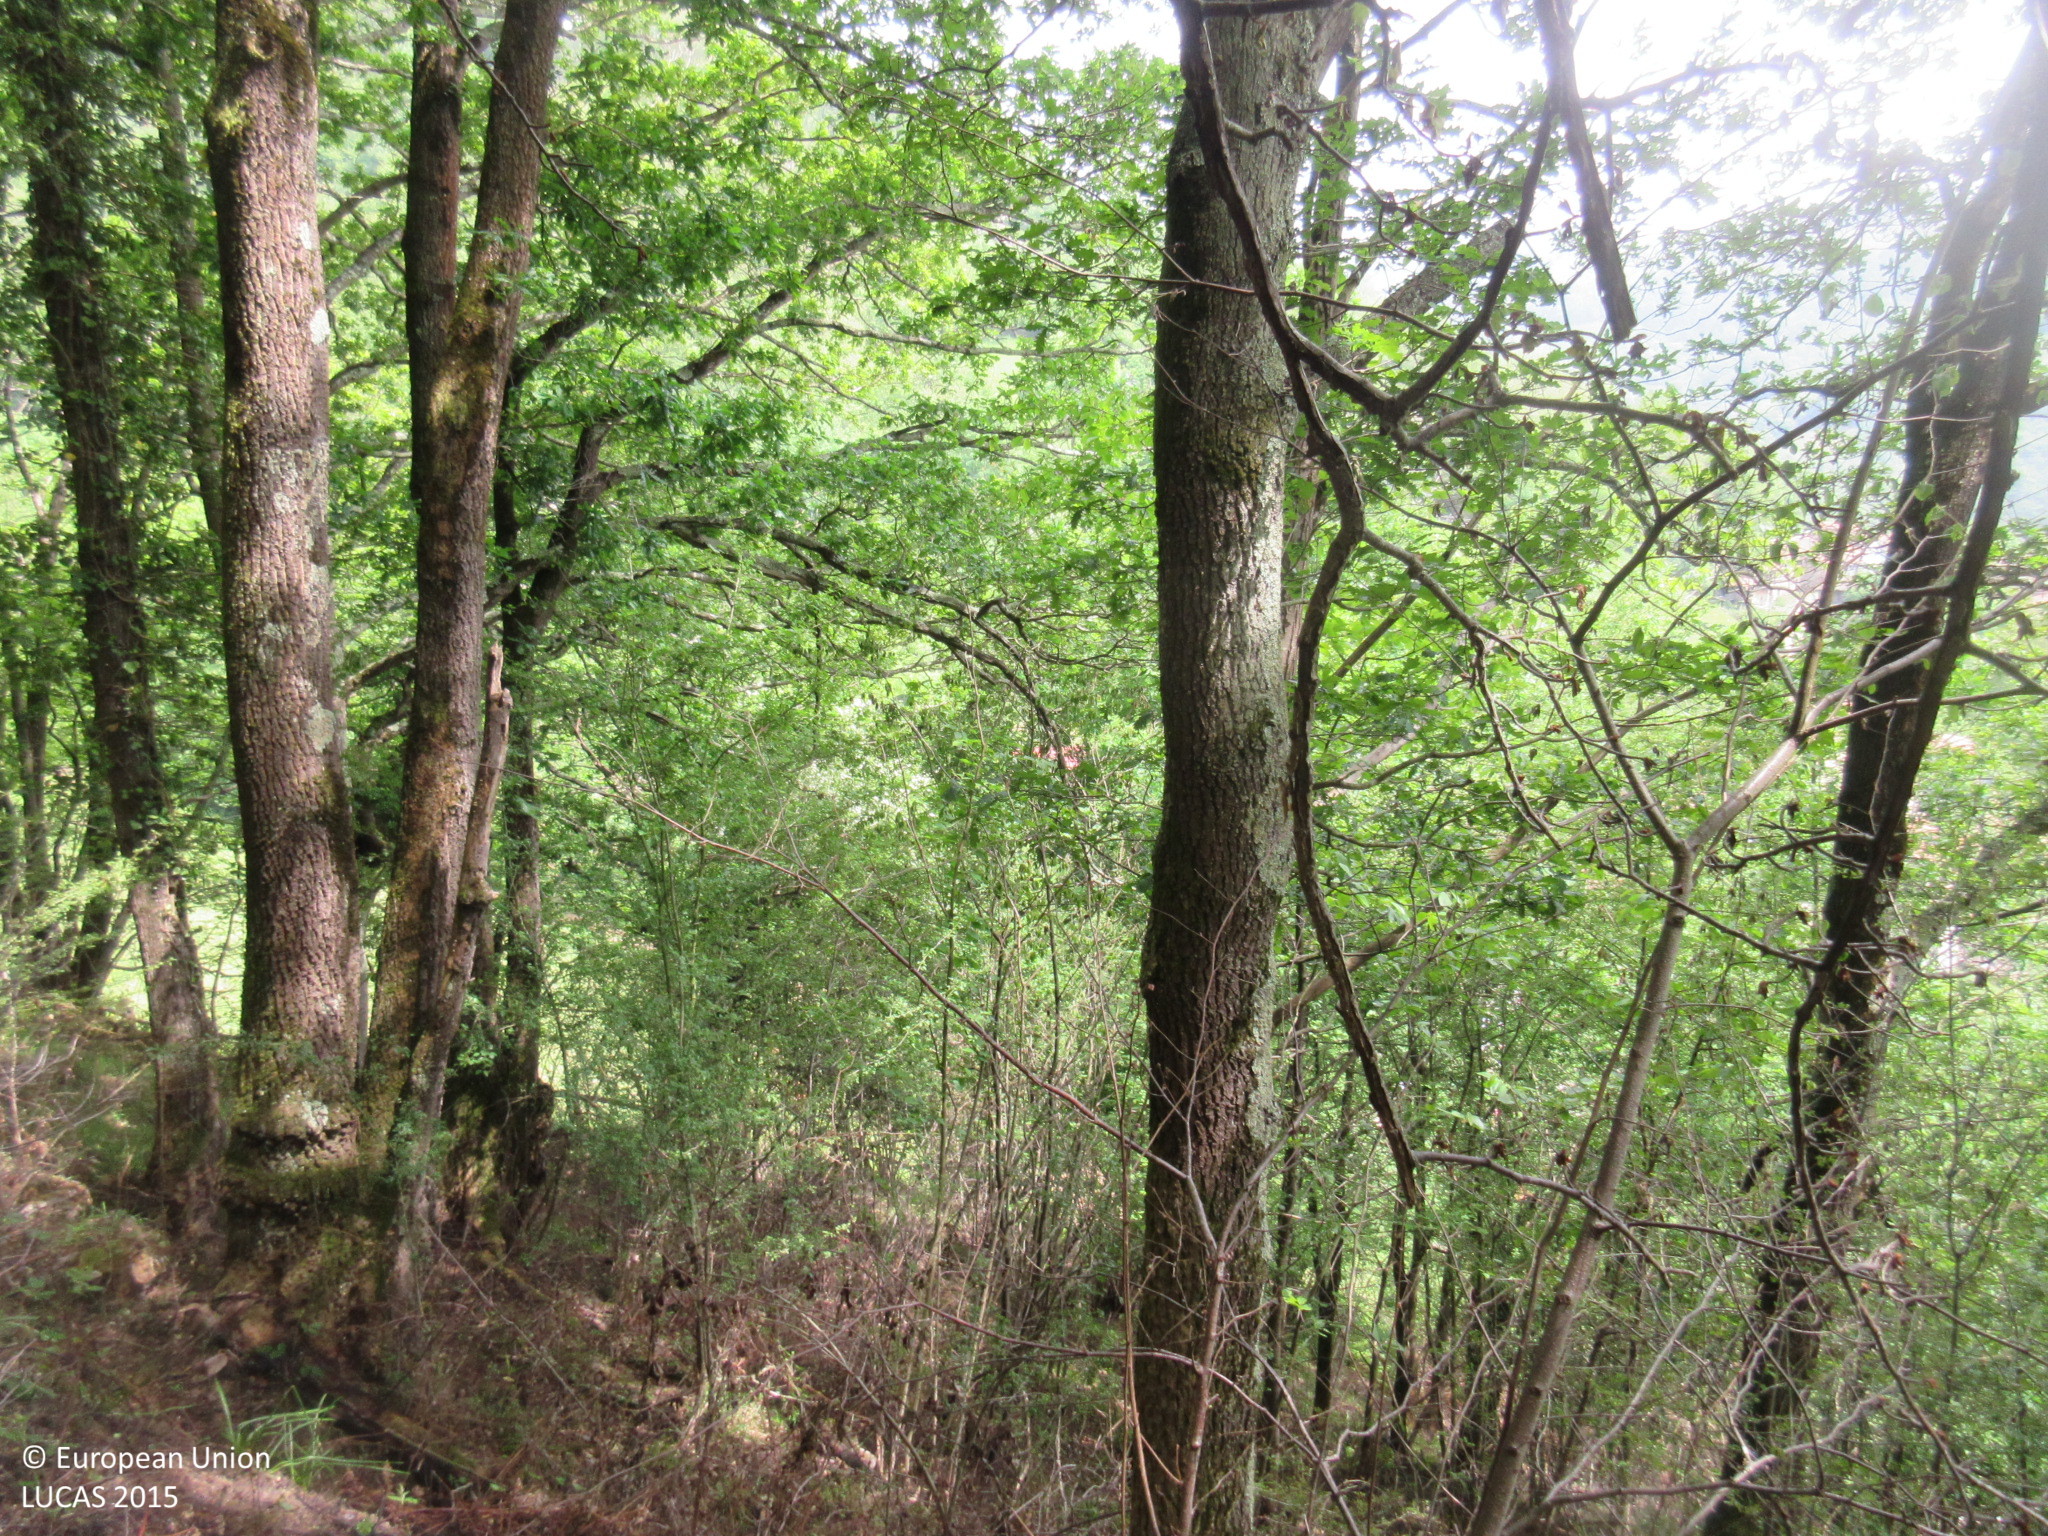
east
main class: Woodland
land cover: Broadleaved woodland
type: acidophilous oak and oak-birch forest
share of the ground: > 75 %
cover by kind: broadleaved forest trees 95 %, unconsolidated bare surface 5 %
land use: Semi-natural and natural areas not in use
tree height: > 5 m
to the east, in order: Broadleaved woodland; Fences; Grassland without tree/shrub cover; Groves; Shrubland without tree cover; Electric lines; Broadleaved woodland
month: May
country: ES
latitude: 43.2629
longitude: -5.5406
